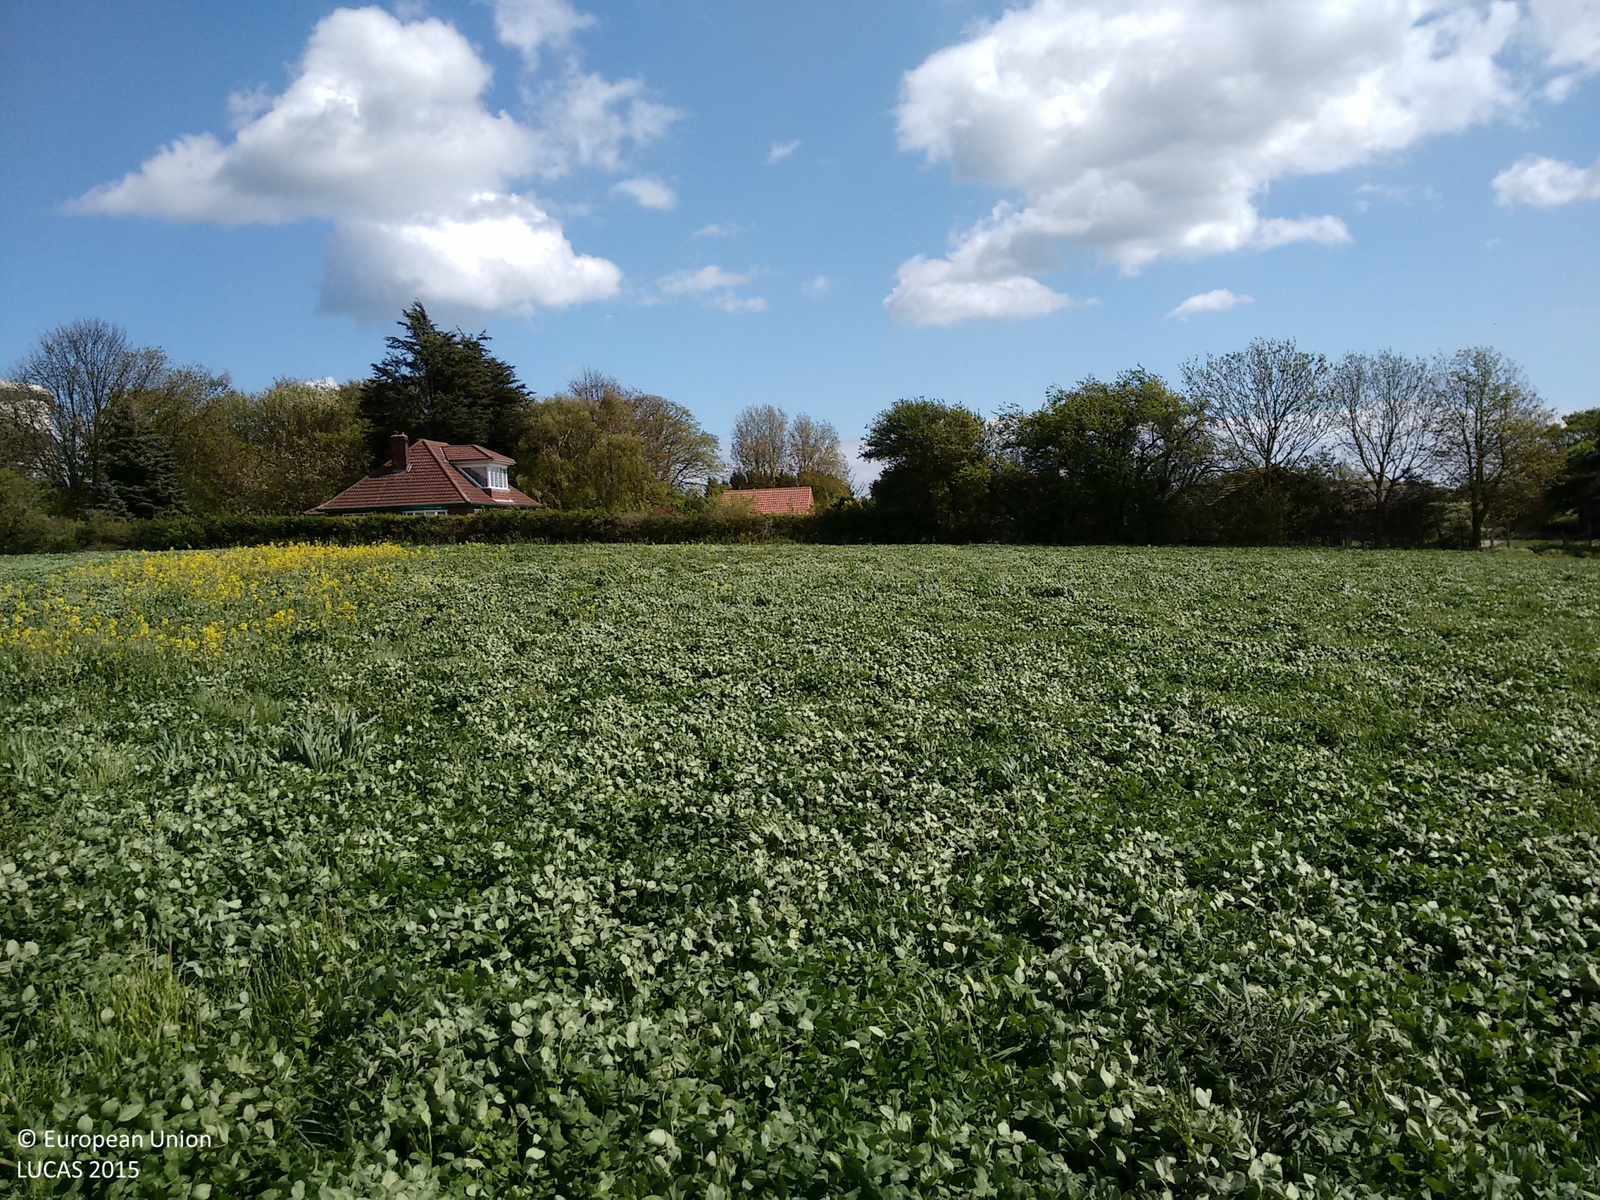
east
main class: Cropland
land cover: Clovers
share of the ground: > 75 %
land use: Agriculture (excluding fallow land and kitchen gardens)
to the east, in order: Clovers; Abandoned hedges; Artificial constructions in urban areas; Abandoned hedges; Grassland without tree/shrub cover; Artificial constructions in urban areas
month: May
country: GB
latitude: 53.8782
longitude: -0.1790
